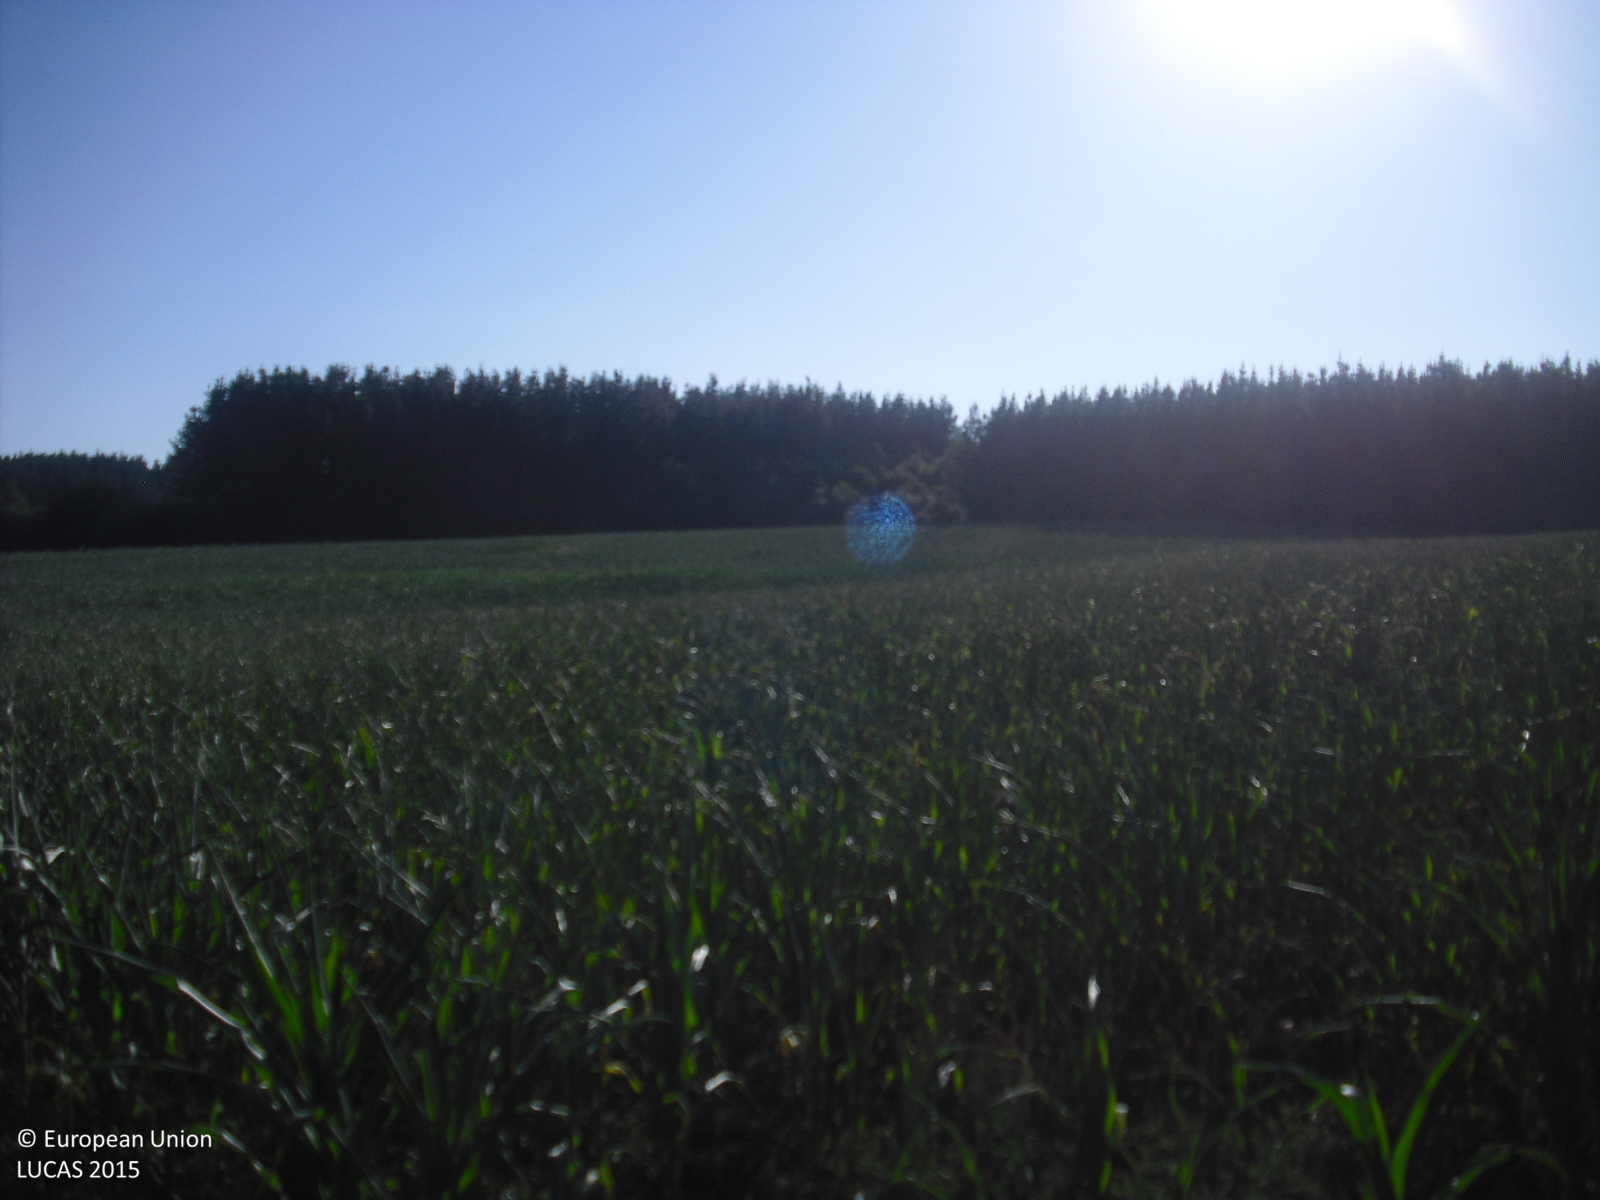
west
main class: Cropland
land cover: Maize
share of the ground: > 75 %
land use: Agriculture (excluding fallow land and kitchen gardens)
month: July
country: ES
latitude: 42.5855
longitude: -7.5324
